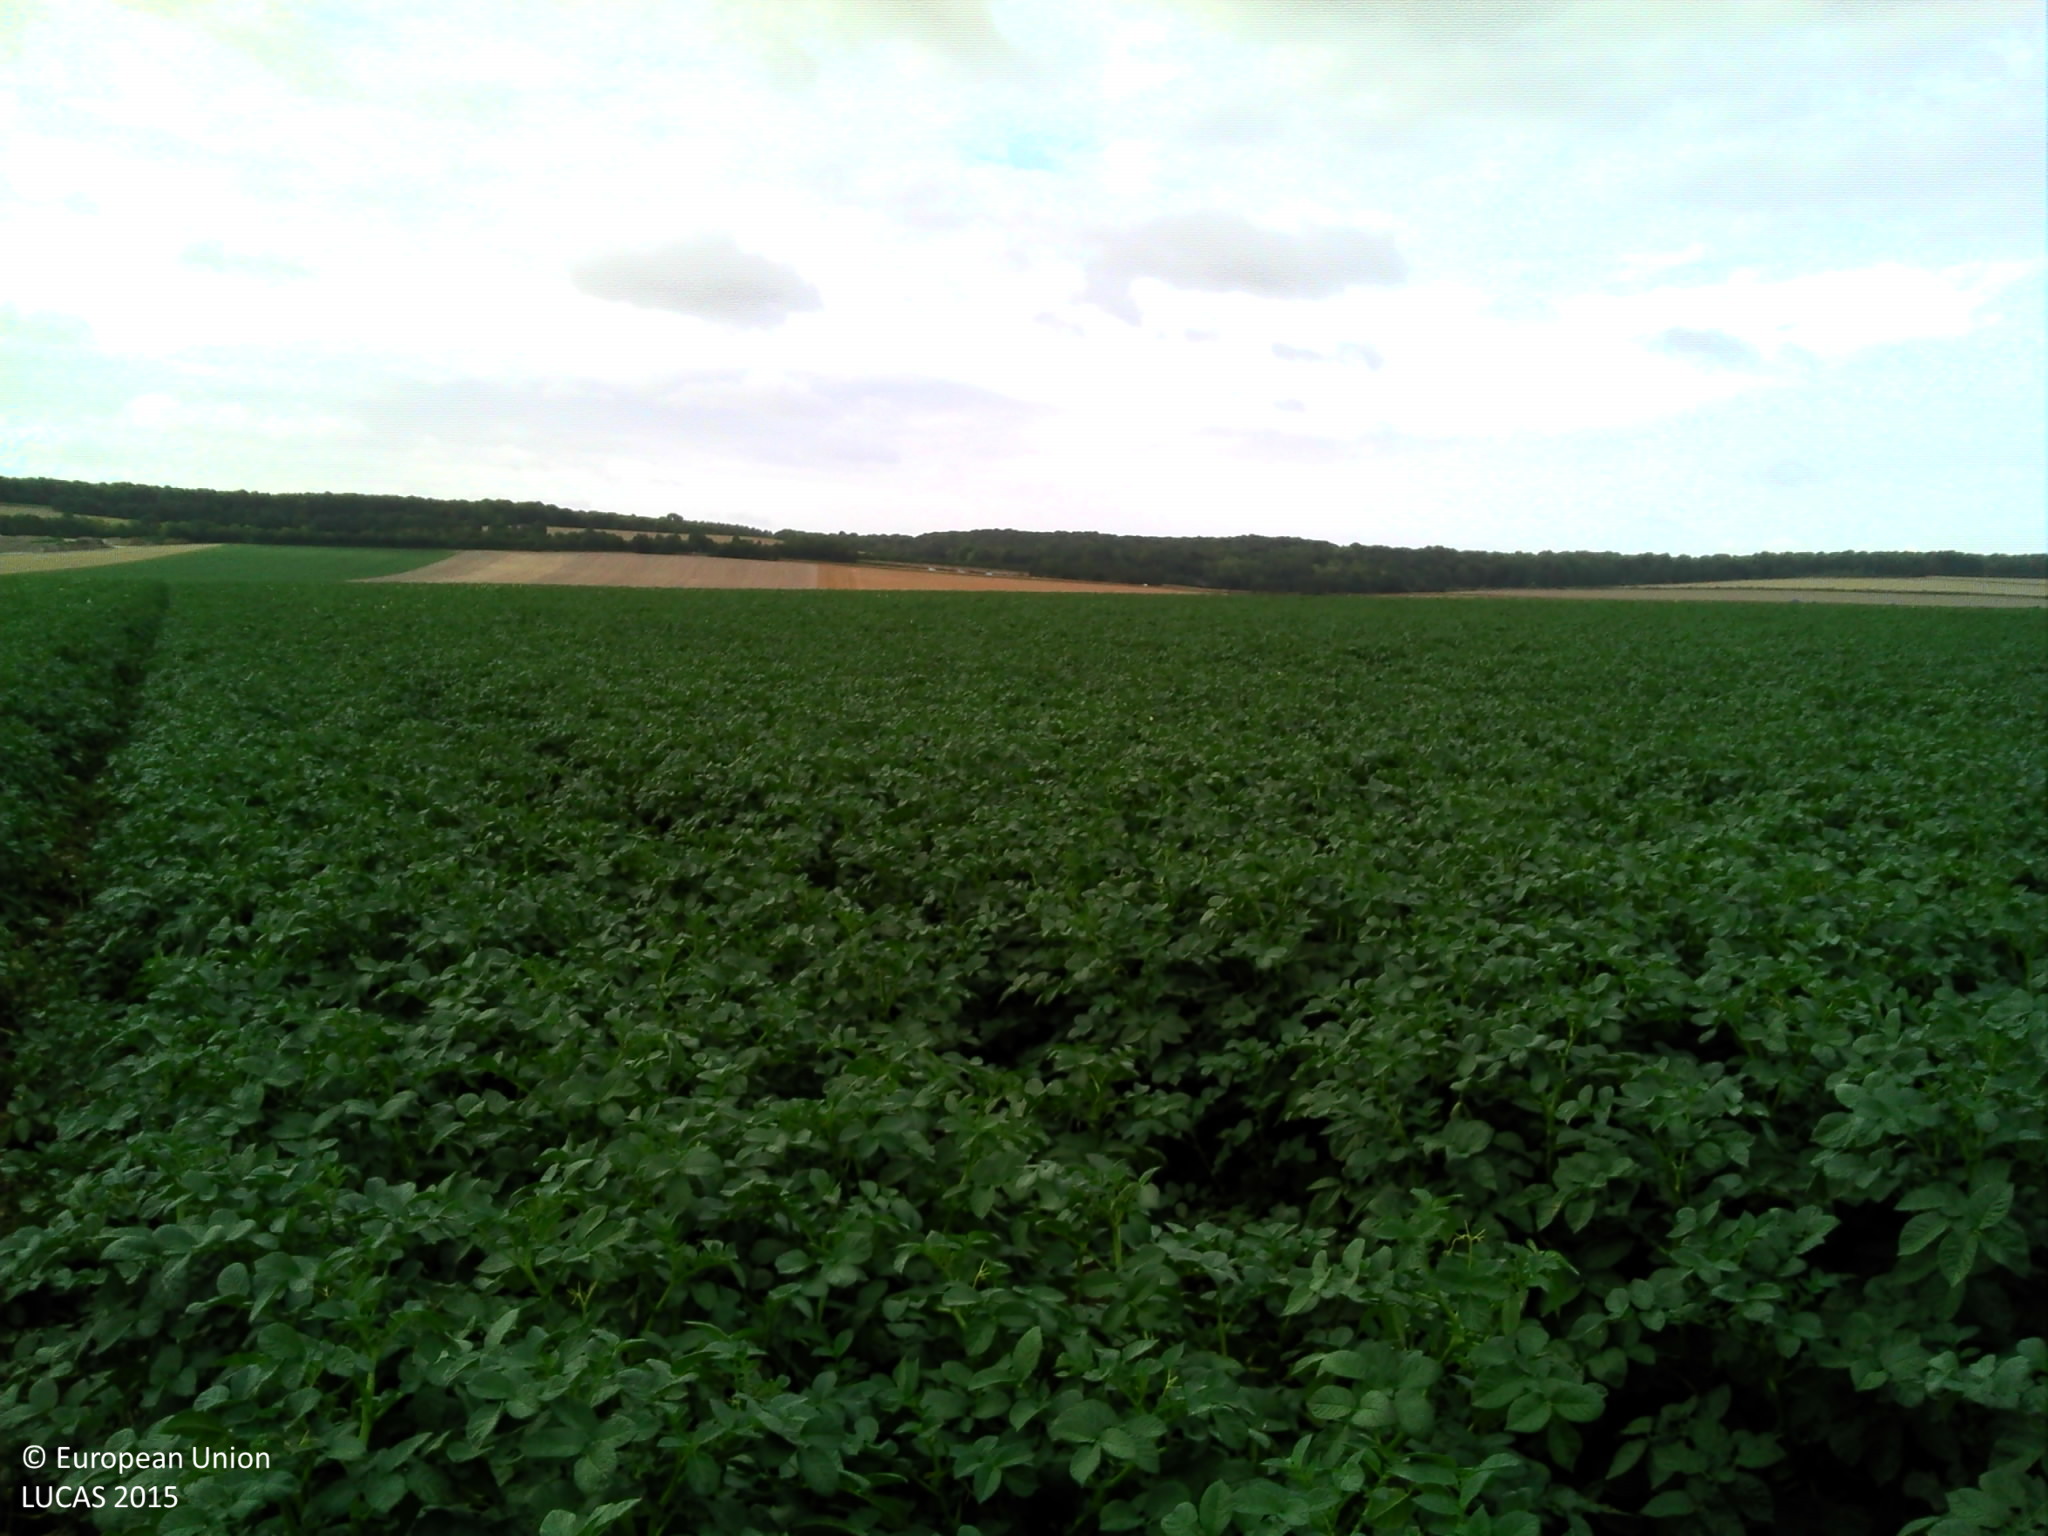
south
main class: Cropland
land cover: Potatoes
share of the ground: > 75 %
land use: Agriculture (excluding fallow land and kitchen gardens)
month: July
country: FR
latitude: 49.8801
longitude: 2.4587
